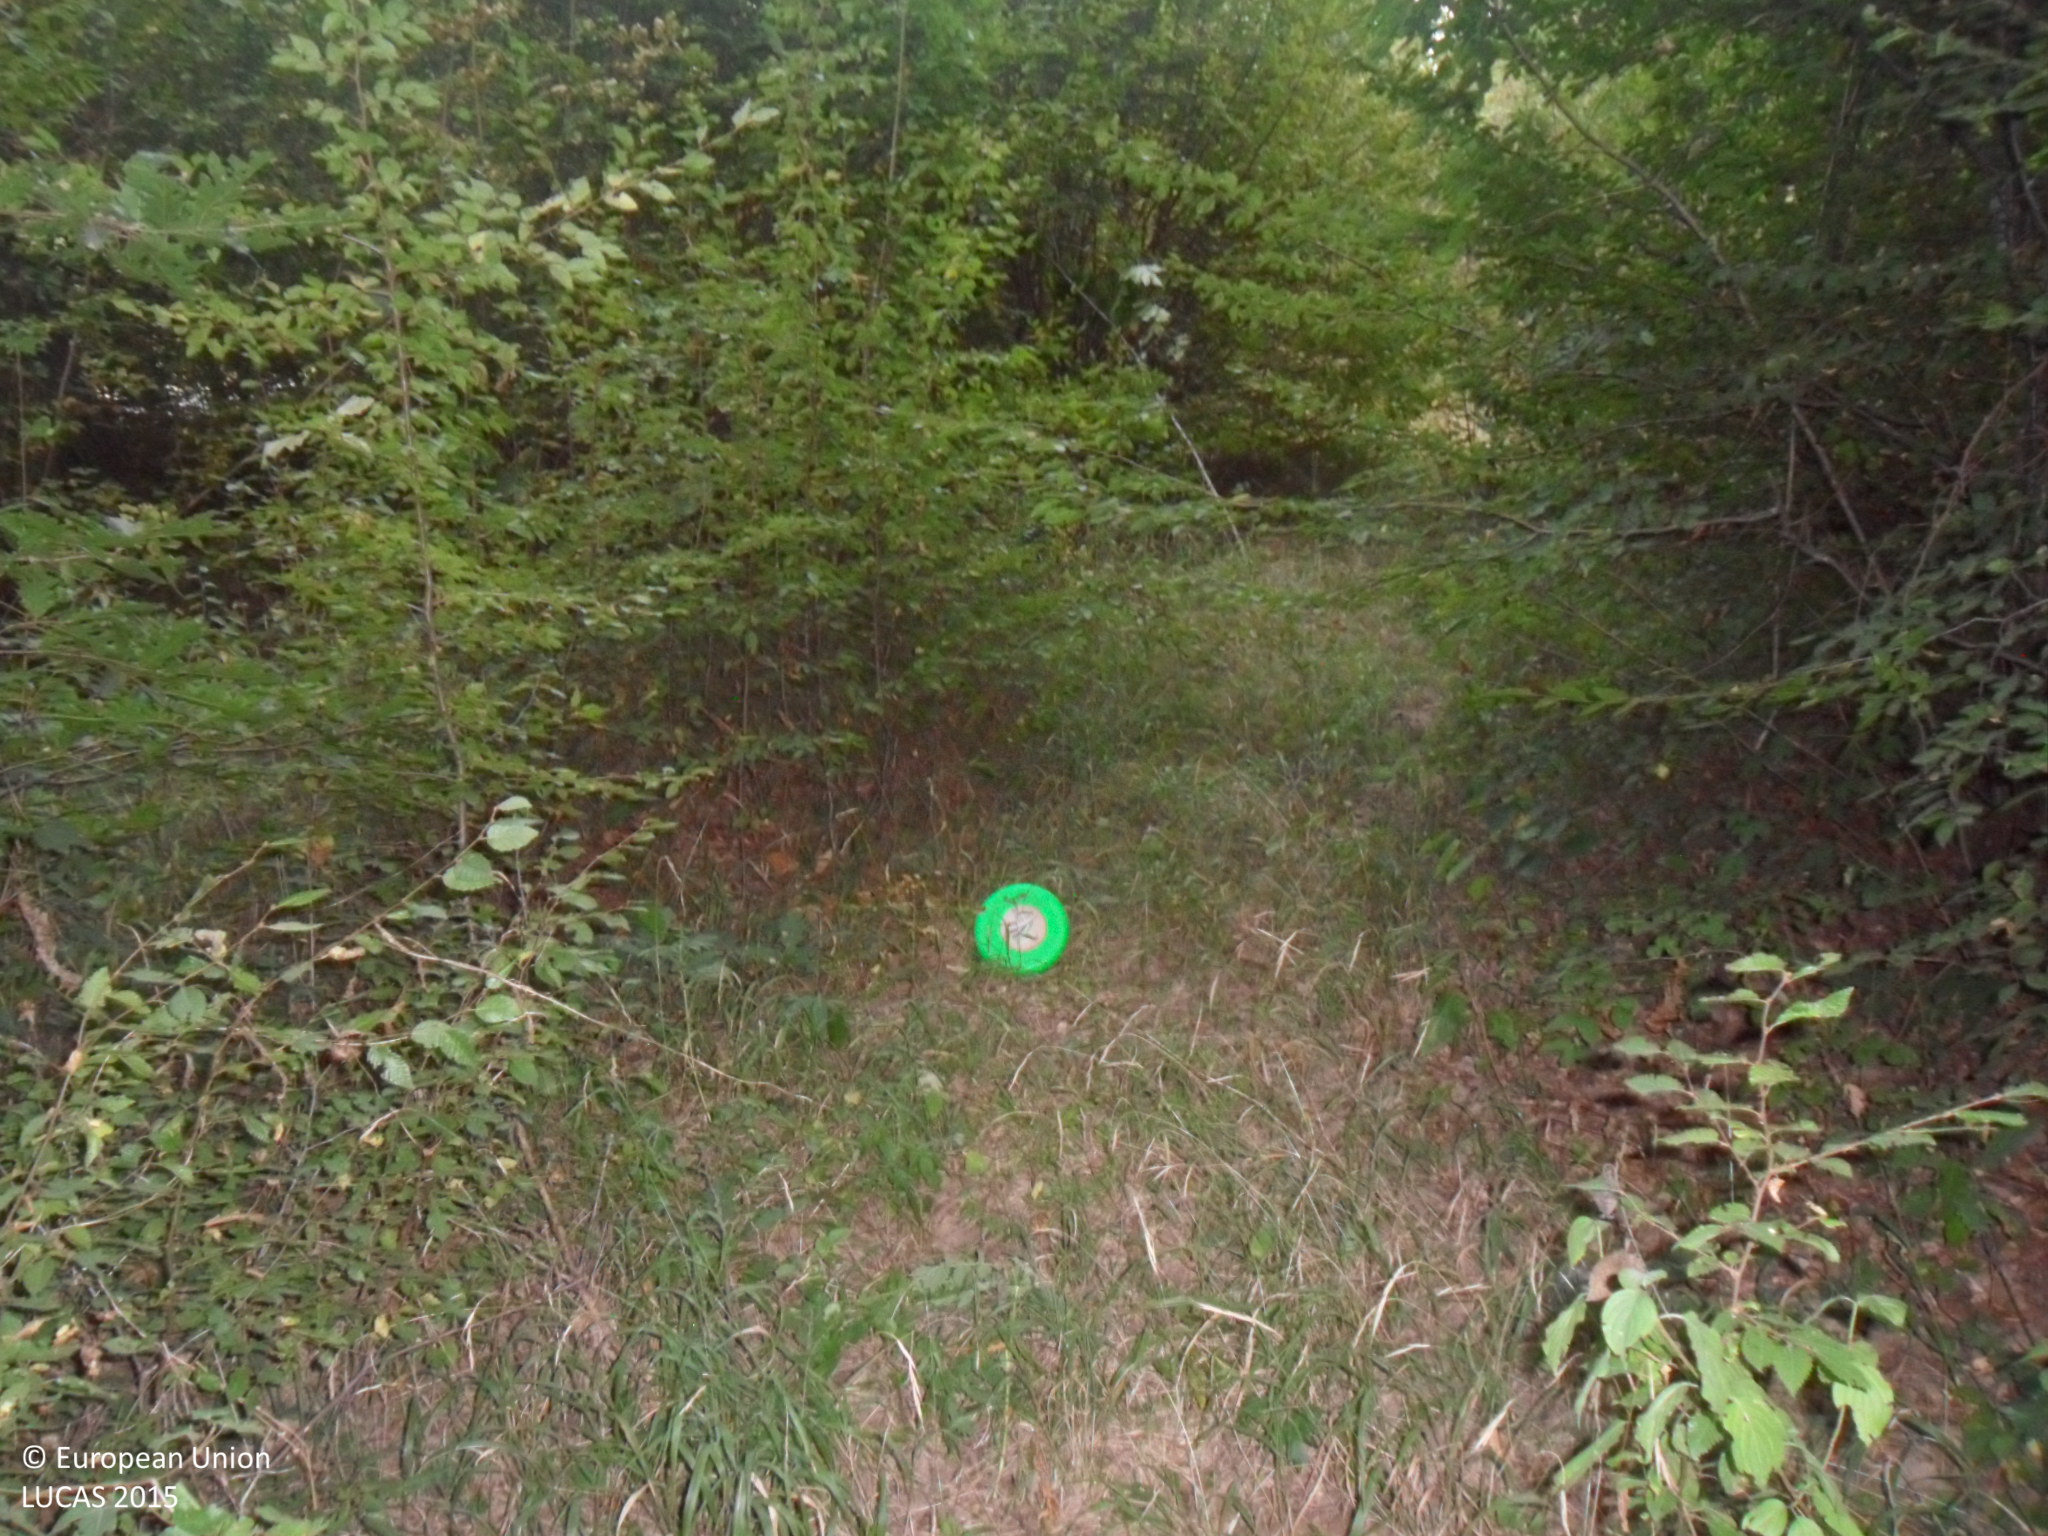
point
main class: Woodland
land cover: Broadleaved woodland
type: mesophytic deciduous forest
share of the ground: > 75 %
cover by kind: broadleaved forest trees 100 %
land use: Forestry
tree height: > 5 m
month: September
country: BG
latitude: 43.6504
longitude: 26.2300
